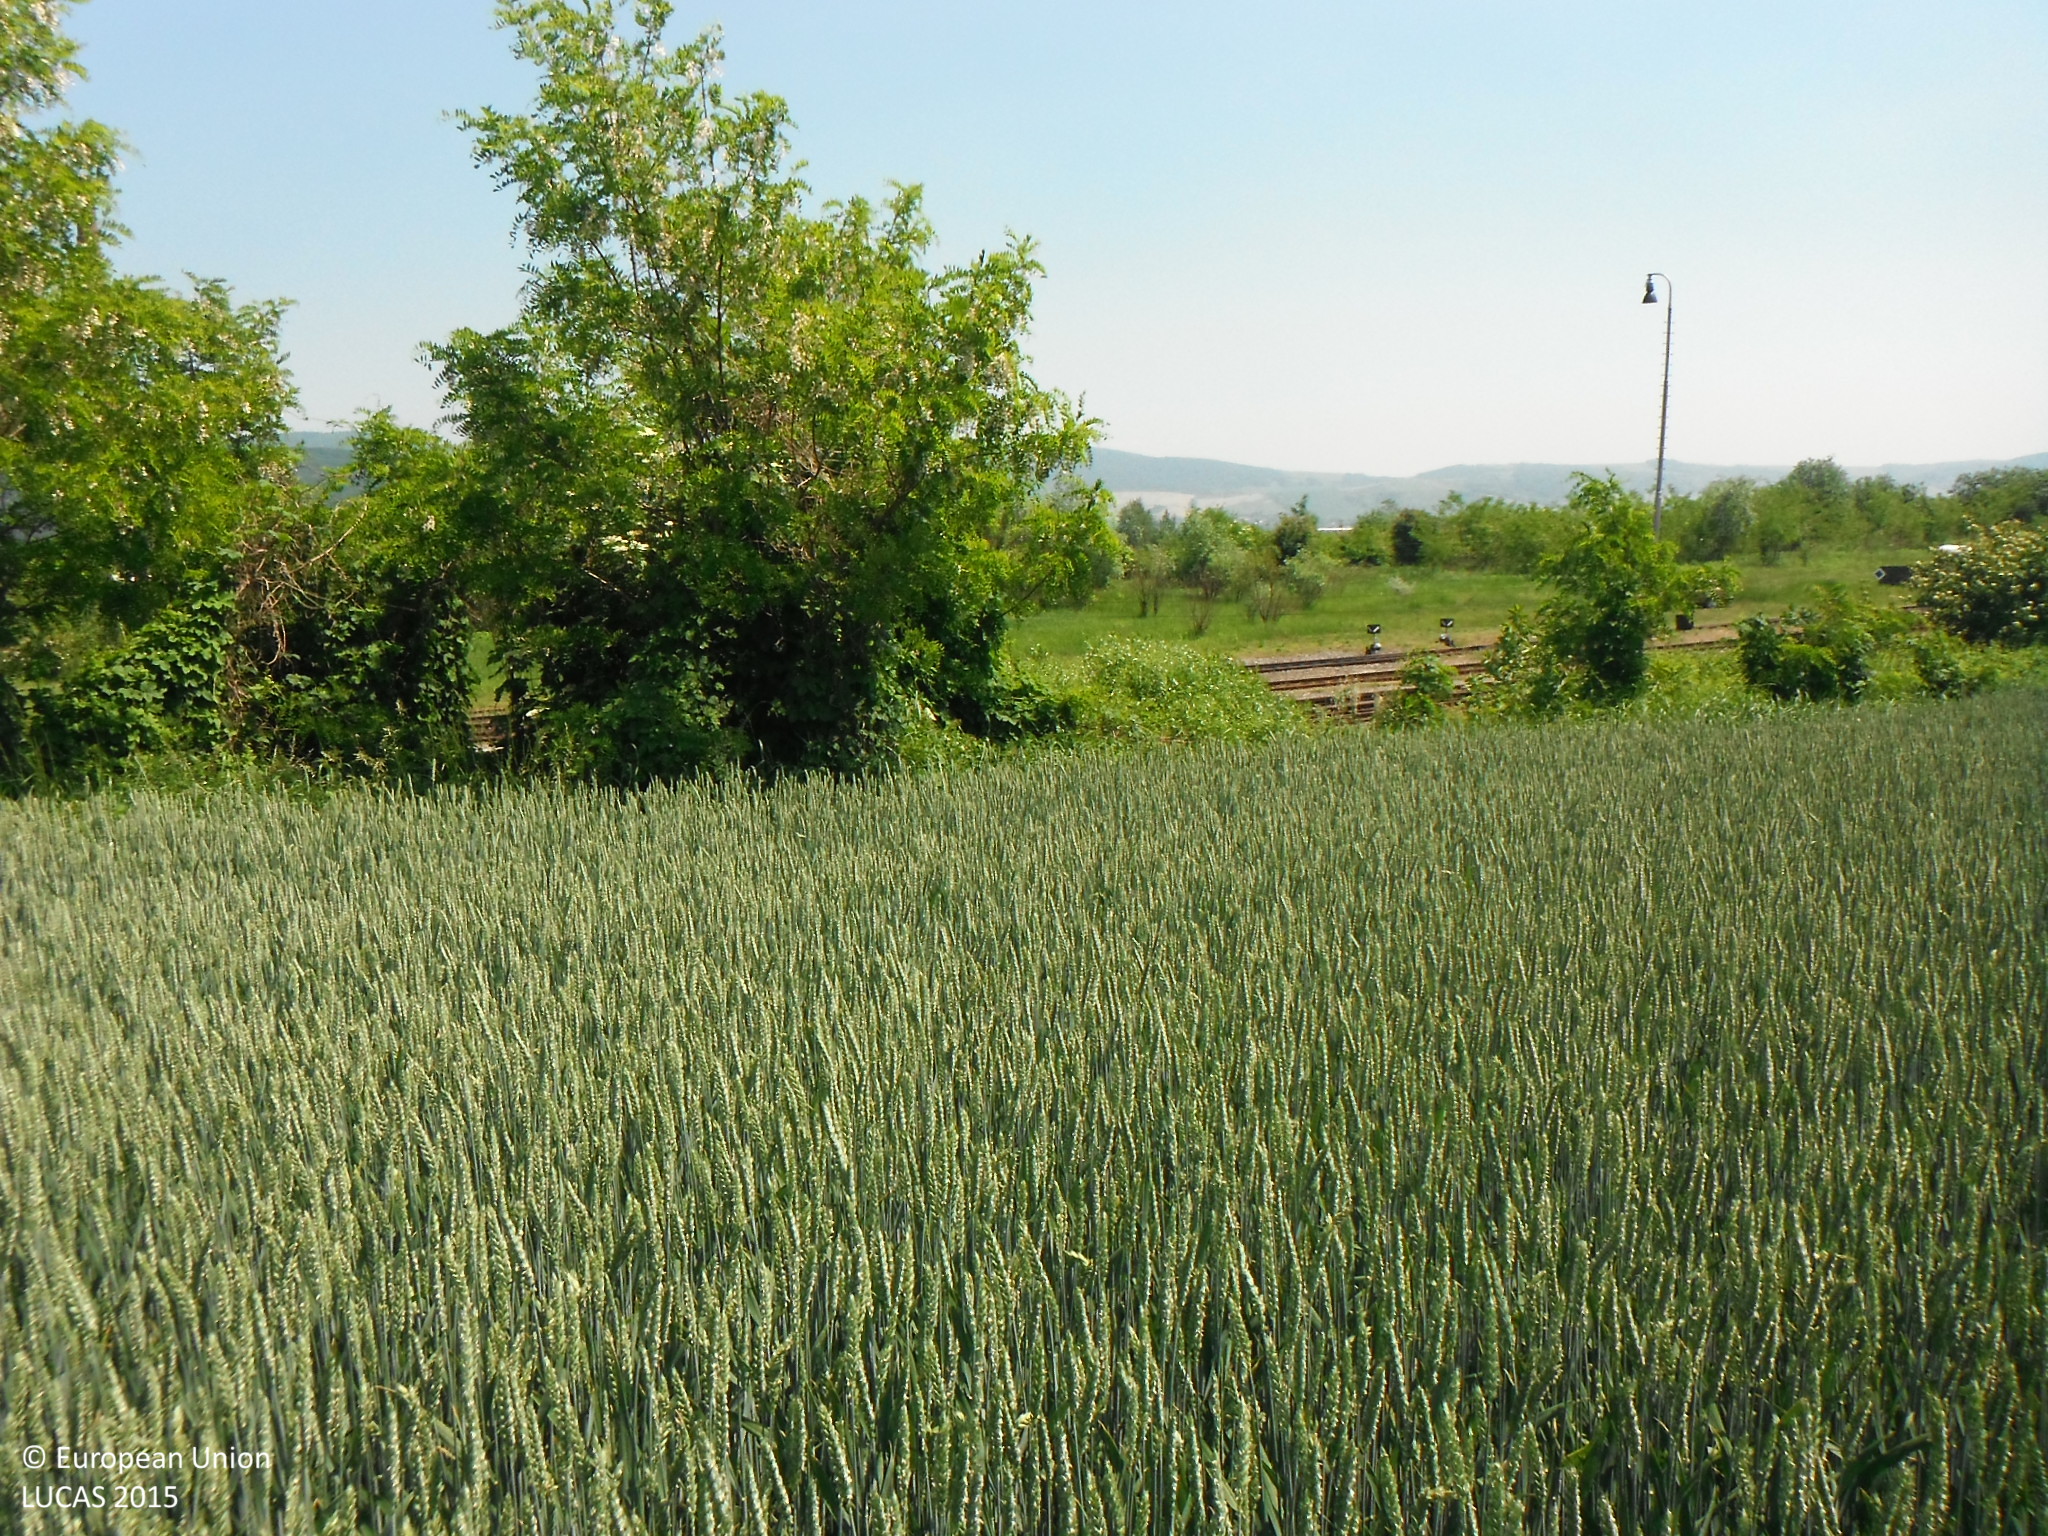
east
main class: Cropland
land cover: Common wheat
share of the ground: > 75 %
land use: Agriculture (excluding fallow land and kitchen gardens)
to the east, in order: Common wheat; Shrubland with sparse tree cover; Spontaneously vegetated surfaces; Ditches and canals; Grass margins; Railways; Grass margins; Tracks; Grassland with sparse tree/shrub cover; Shrubland with sparse tree cover; Artificial constructions in urban areas; Shrubland with sparse tree cover
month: June
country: SK
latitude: 49.0166
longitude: 21.5207
